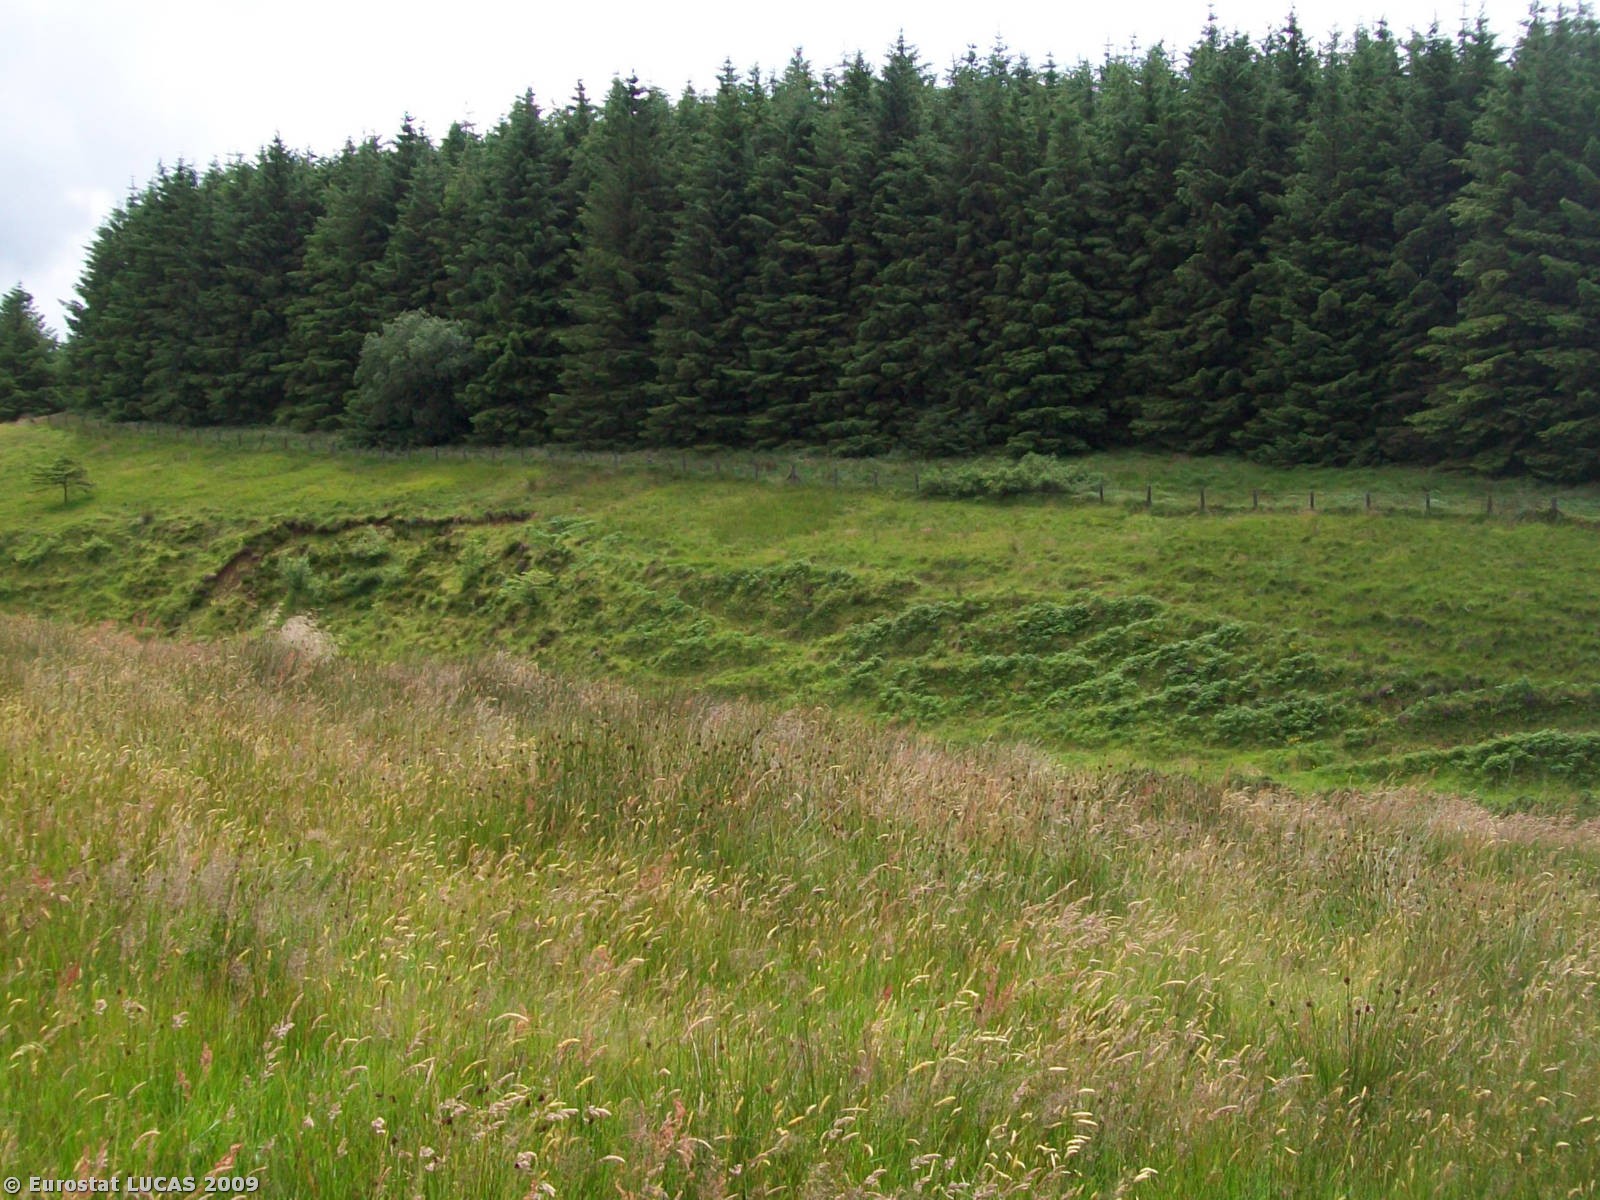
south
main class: Wetlands
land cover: Peatbogs
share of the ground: > 75 %
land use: Unused
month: July
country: GB
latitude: 55.0491
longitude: -6.2525
